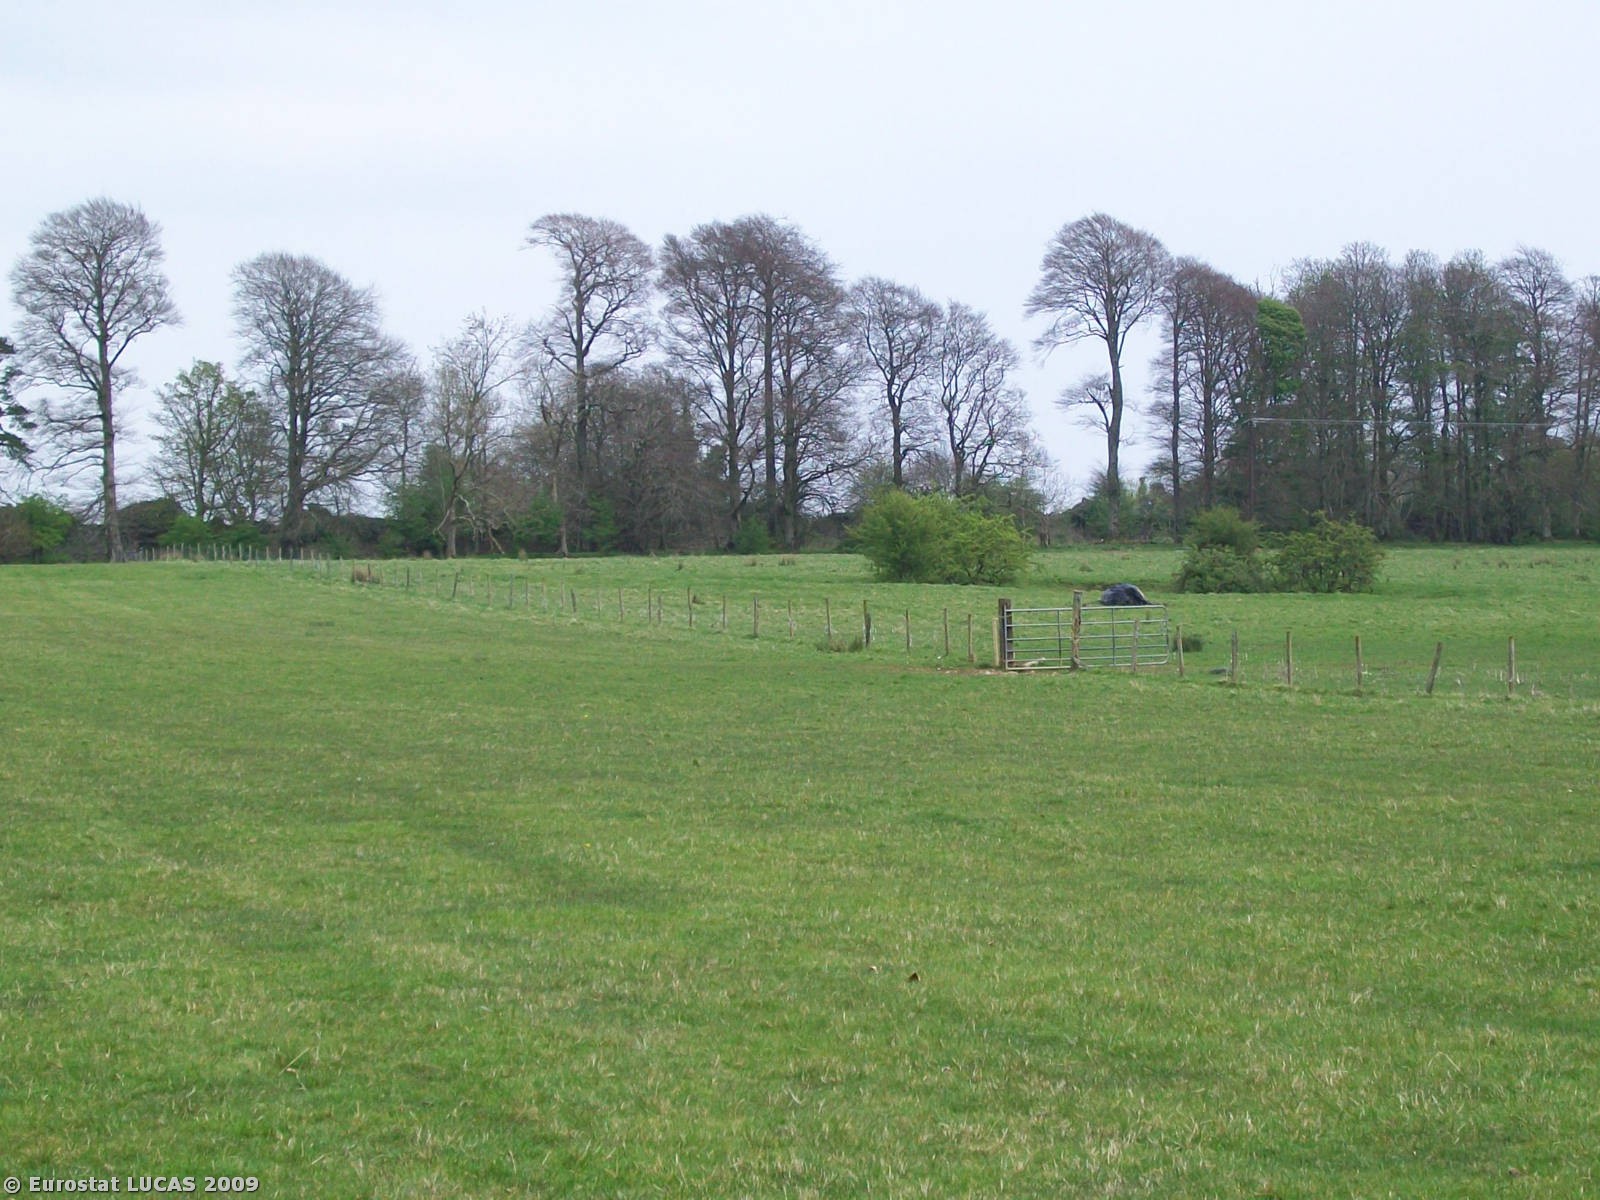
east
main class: Grassland
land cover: Grassland without tree/shrub cover
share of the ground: > 75 %
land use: Agriculture (excluding fallow land and kitchen gardens)
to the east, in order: Grassland without tree/shrub cover; Fences; Ditches and canals; Dry stone walls; Grassland with sparse tree/shrub cover
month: April
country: IE
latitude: 53.6185
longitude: -8.1554
